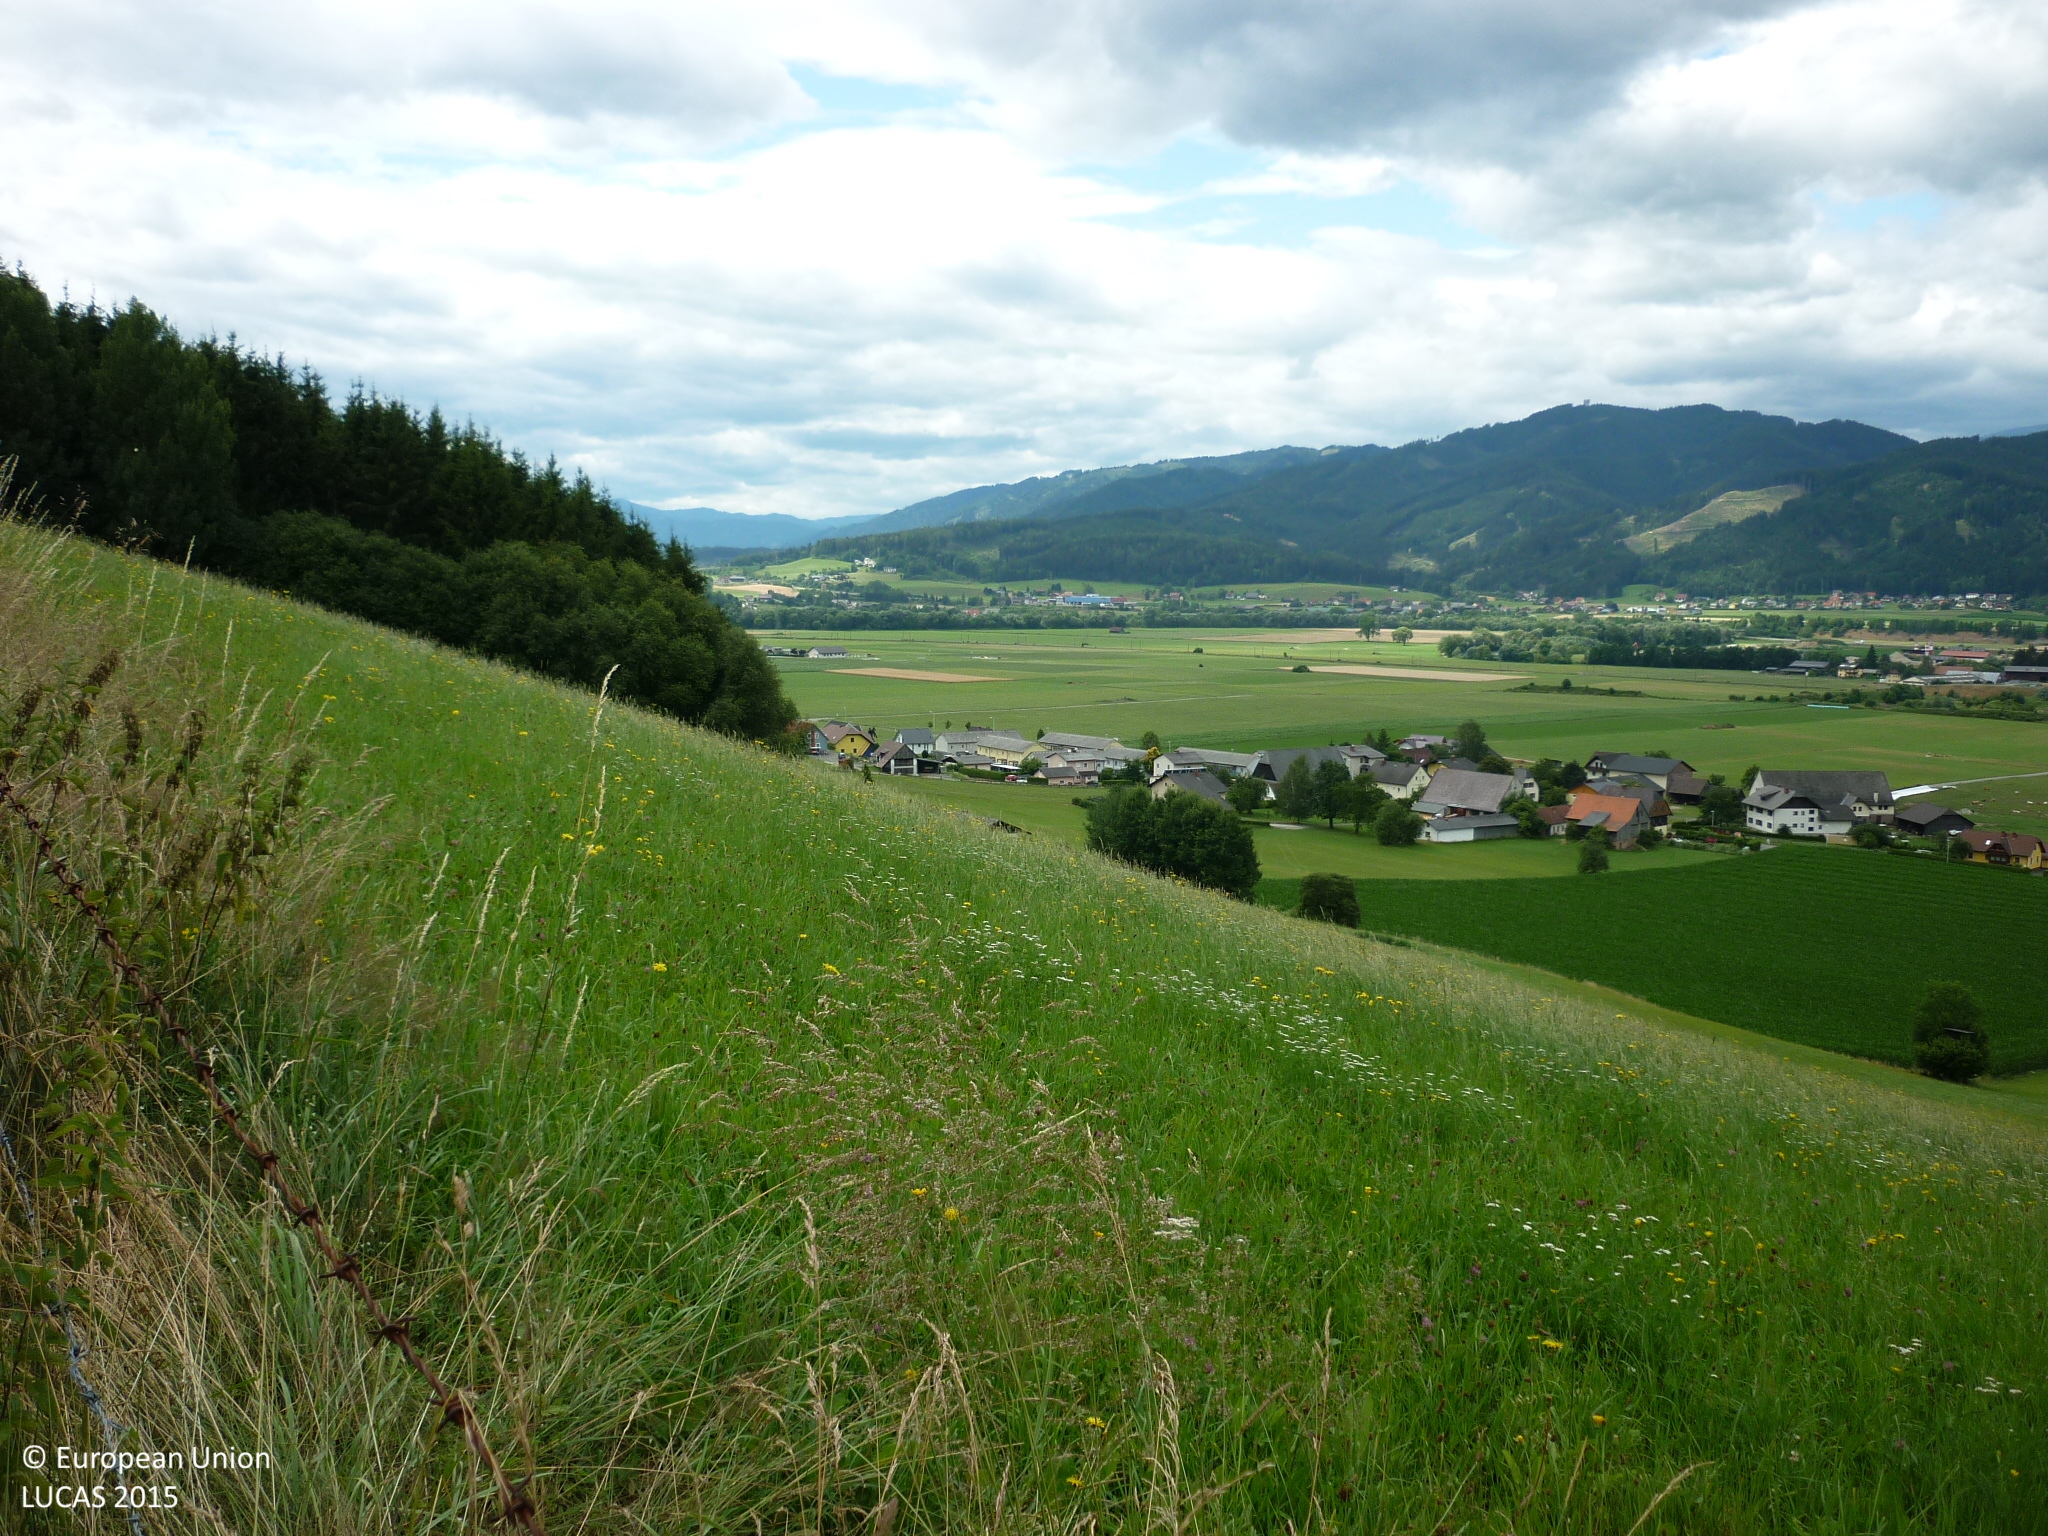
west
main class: Grassland
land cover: Grassland without tree/shrub cover
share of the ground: > 75 %
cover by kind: herbaceous plants 100 %
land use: Agriculture (excluding fallow land and kitchen gardens)
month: July
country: AT
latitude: 47.2323
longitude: 14.8731
